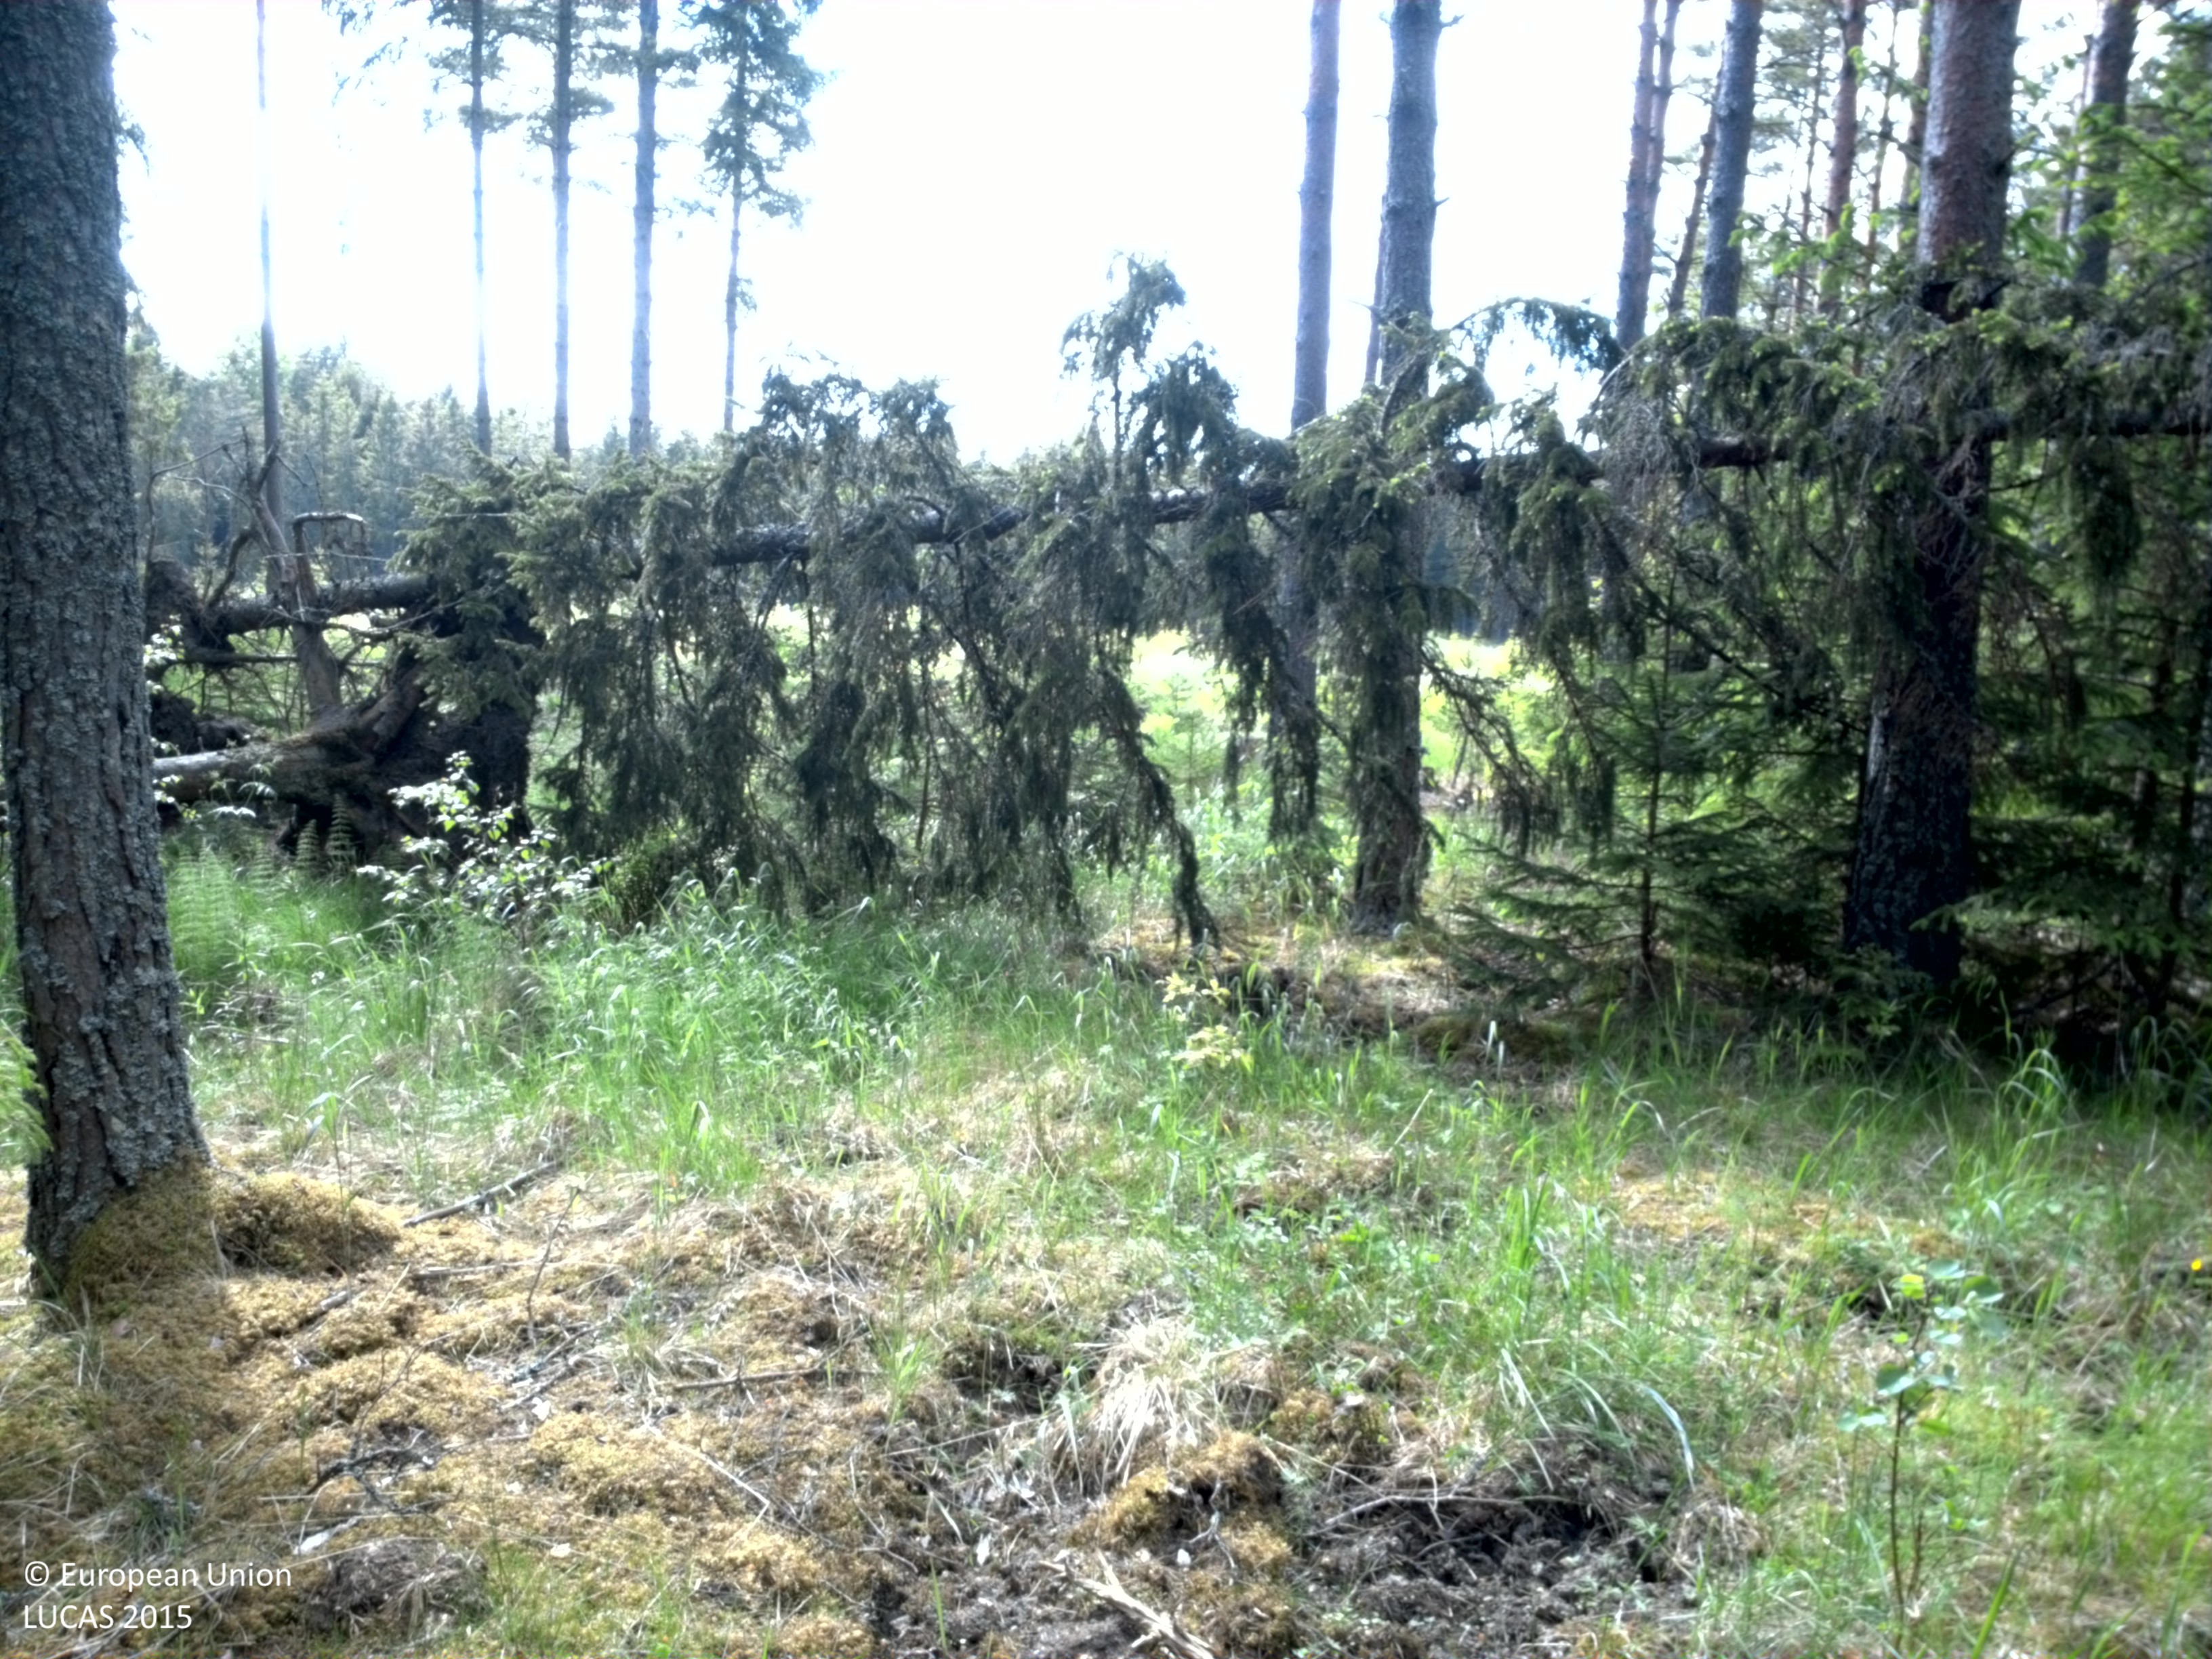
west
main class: Woodland
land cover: Spruce dominated coniferous woodland
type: boreal forest
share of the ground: 50 - 75 %
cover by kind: coniferous forest trees 50 %, lichens and mosses 35 %, herbaceous plants 10 %, broadleaved forest trees 5 %
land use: Forestry
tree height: > 5 m
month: June
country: SE
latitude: 58.4173
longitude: 16.2442
